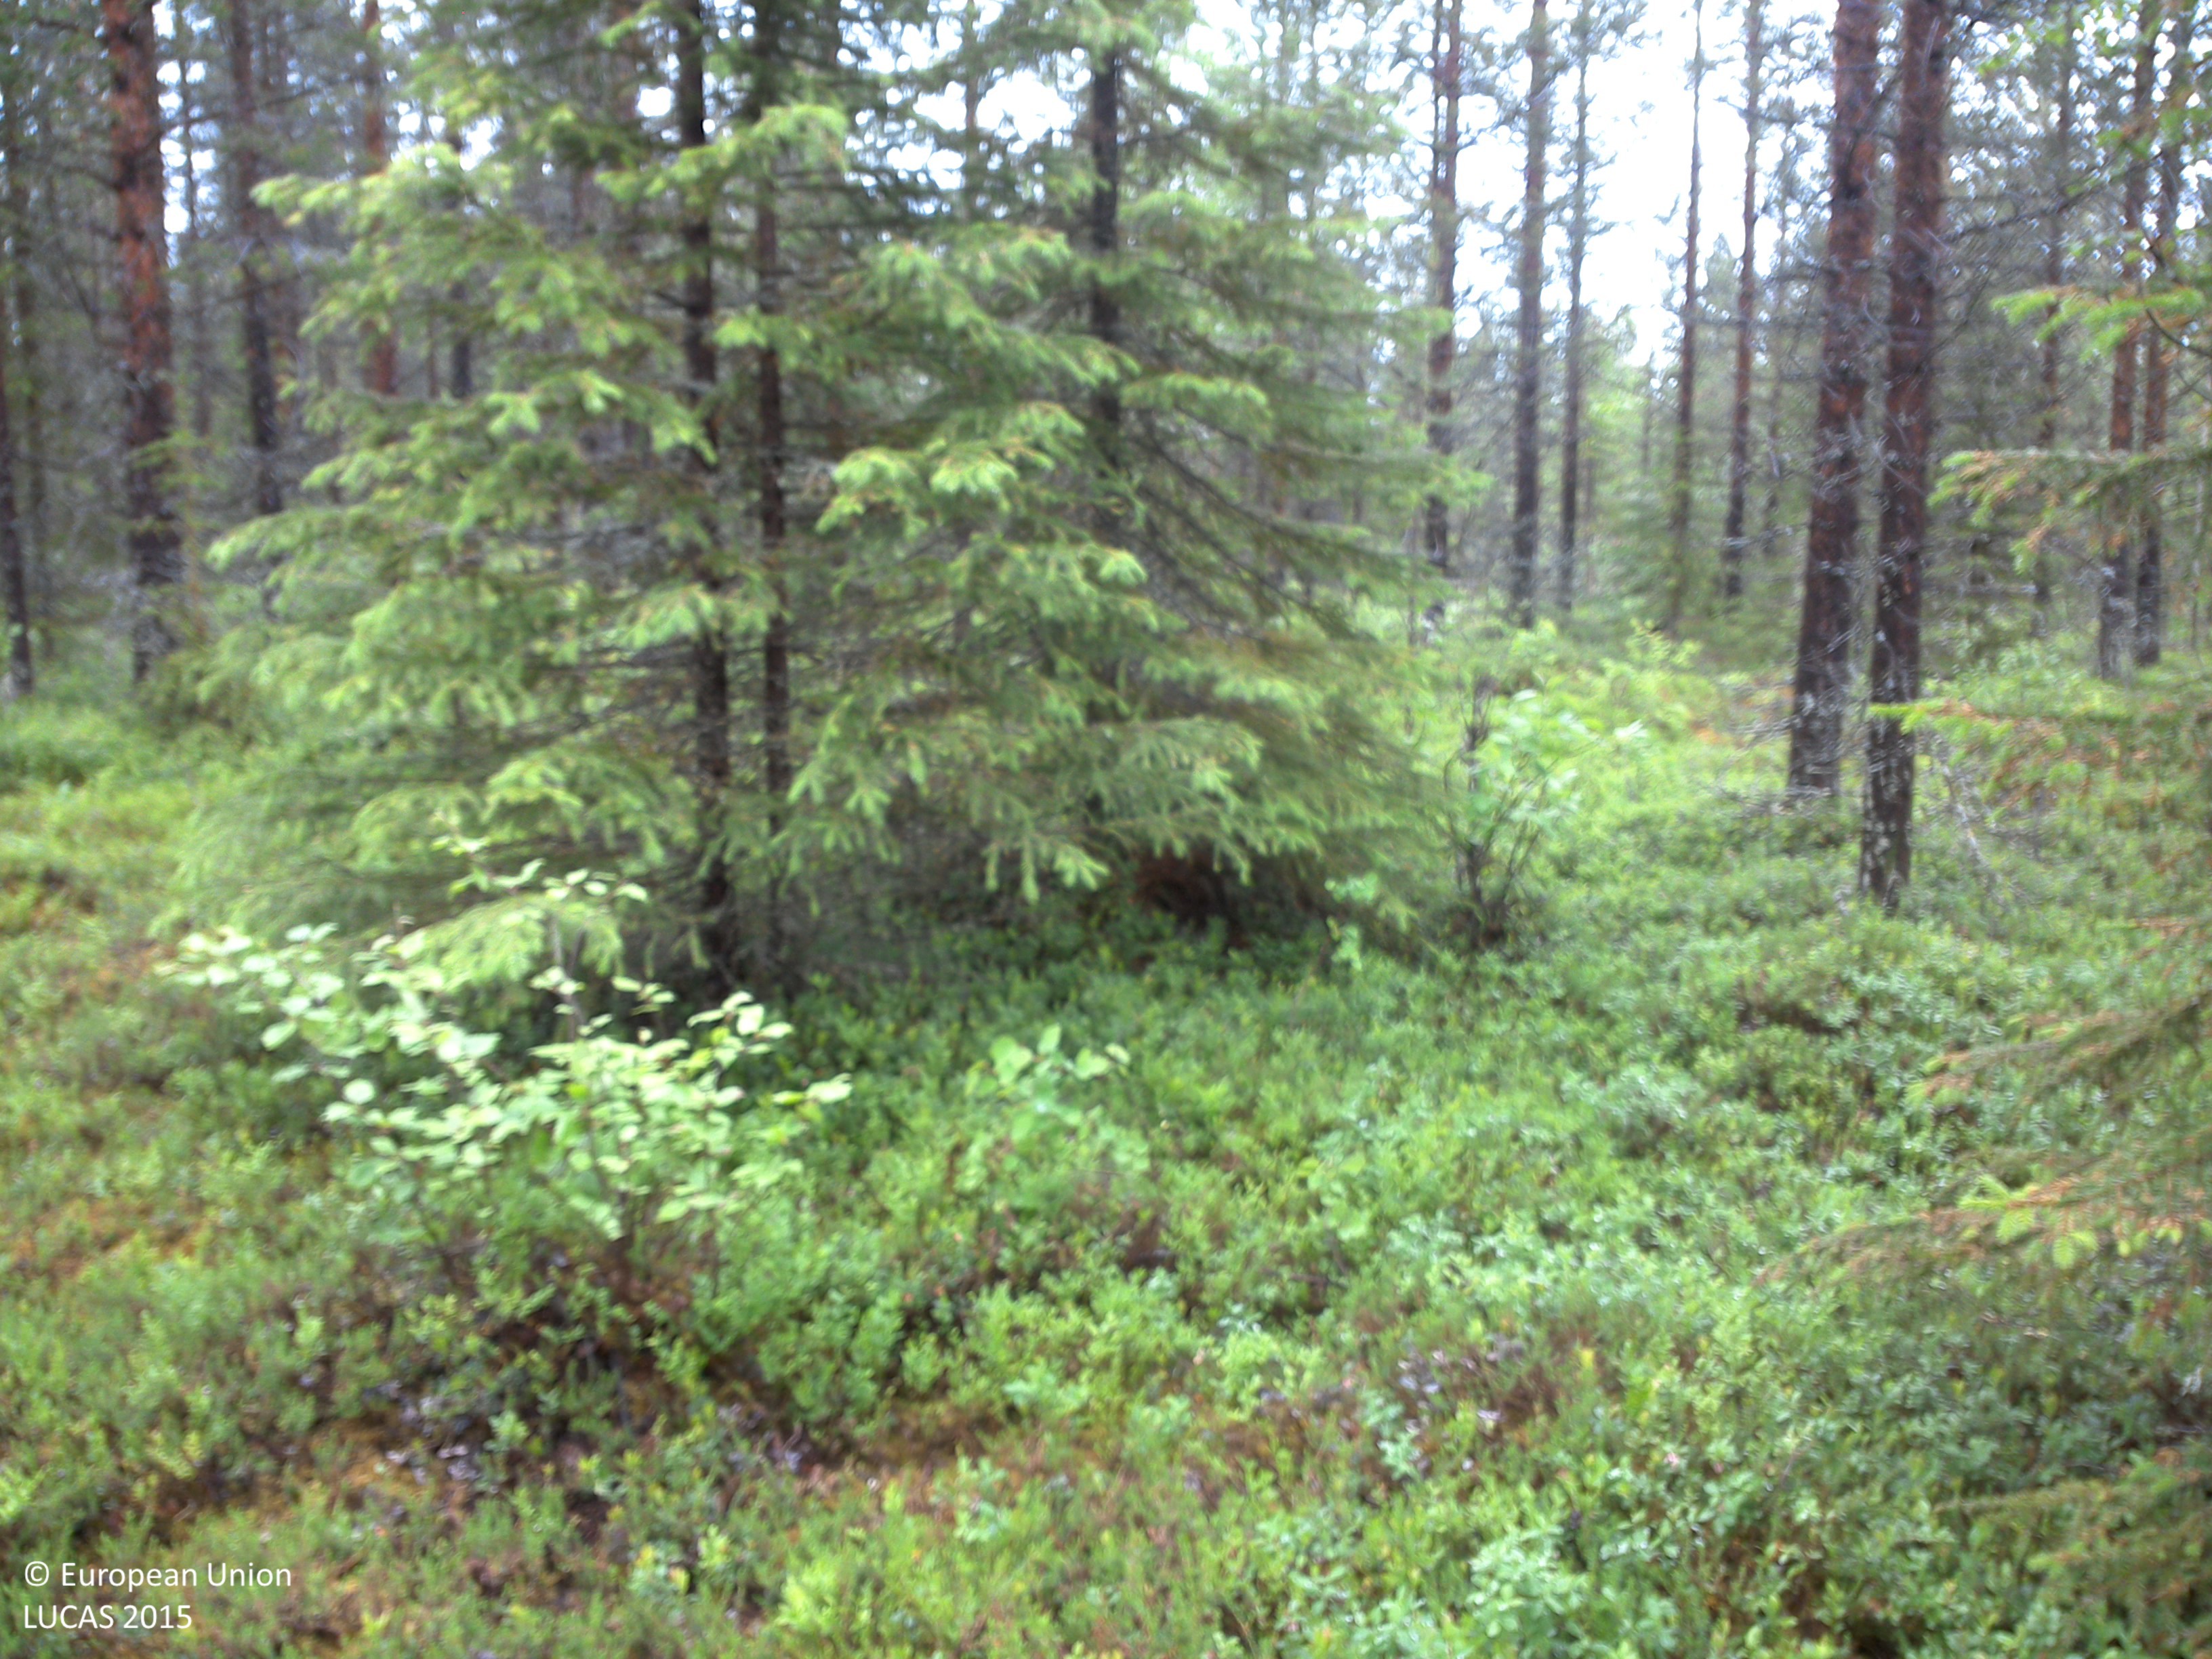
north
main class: Woodland
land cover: Pine dominated mixed woodland
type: boreal forest
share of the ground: 25 - 50 %
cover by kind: shrubs 65 %, coniferous forest trees 25 %, broadleaved forest trees 10 %
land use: Forestry
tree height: > 5 m
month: July
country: SE
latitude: 67.0887
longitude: 23.5804
